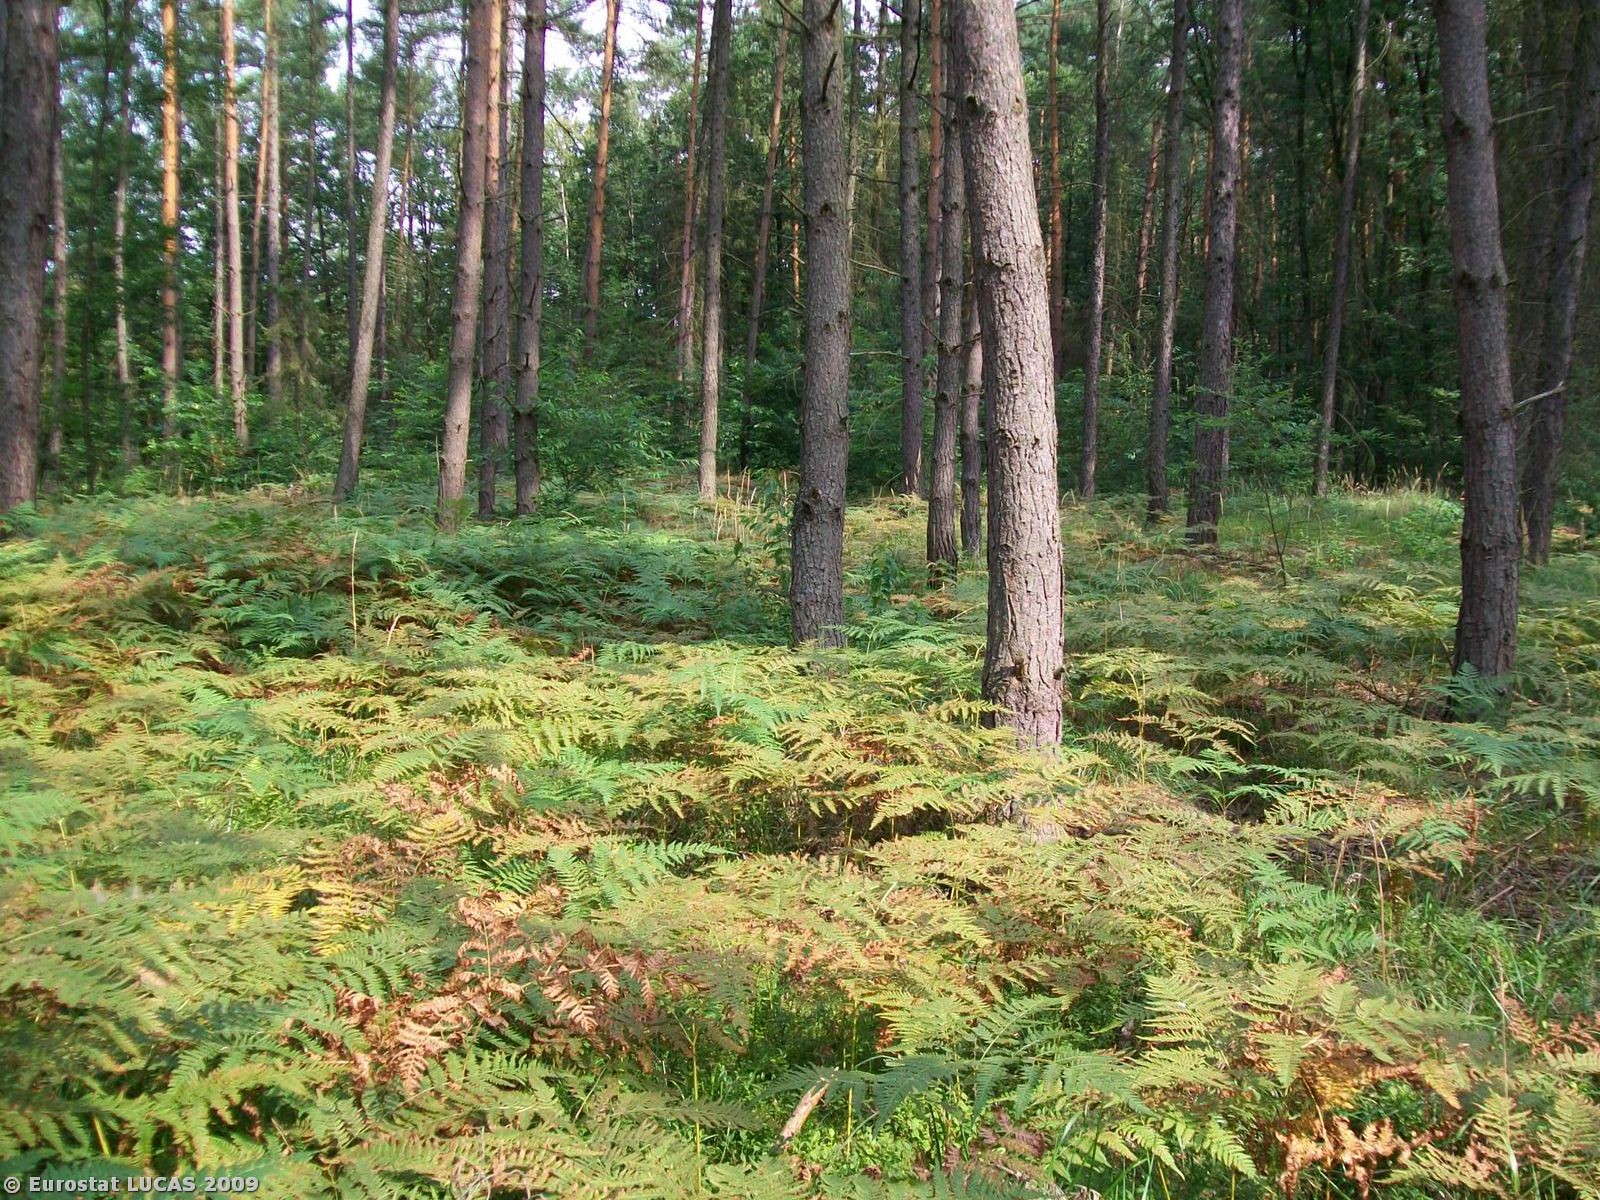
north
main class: Woodland
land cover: Mixed woodland
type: hemiboreal forest and nemoral coniferous forest and mixed broadleaved-coniferous forest
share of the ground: > 75 %
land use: Forestry
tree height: > 5 m
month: August
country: PL
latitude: 51.1729
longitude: 17.9250
